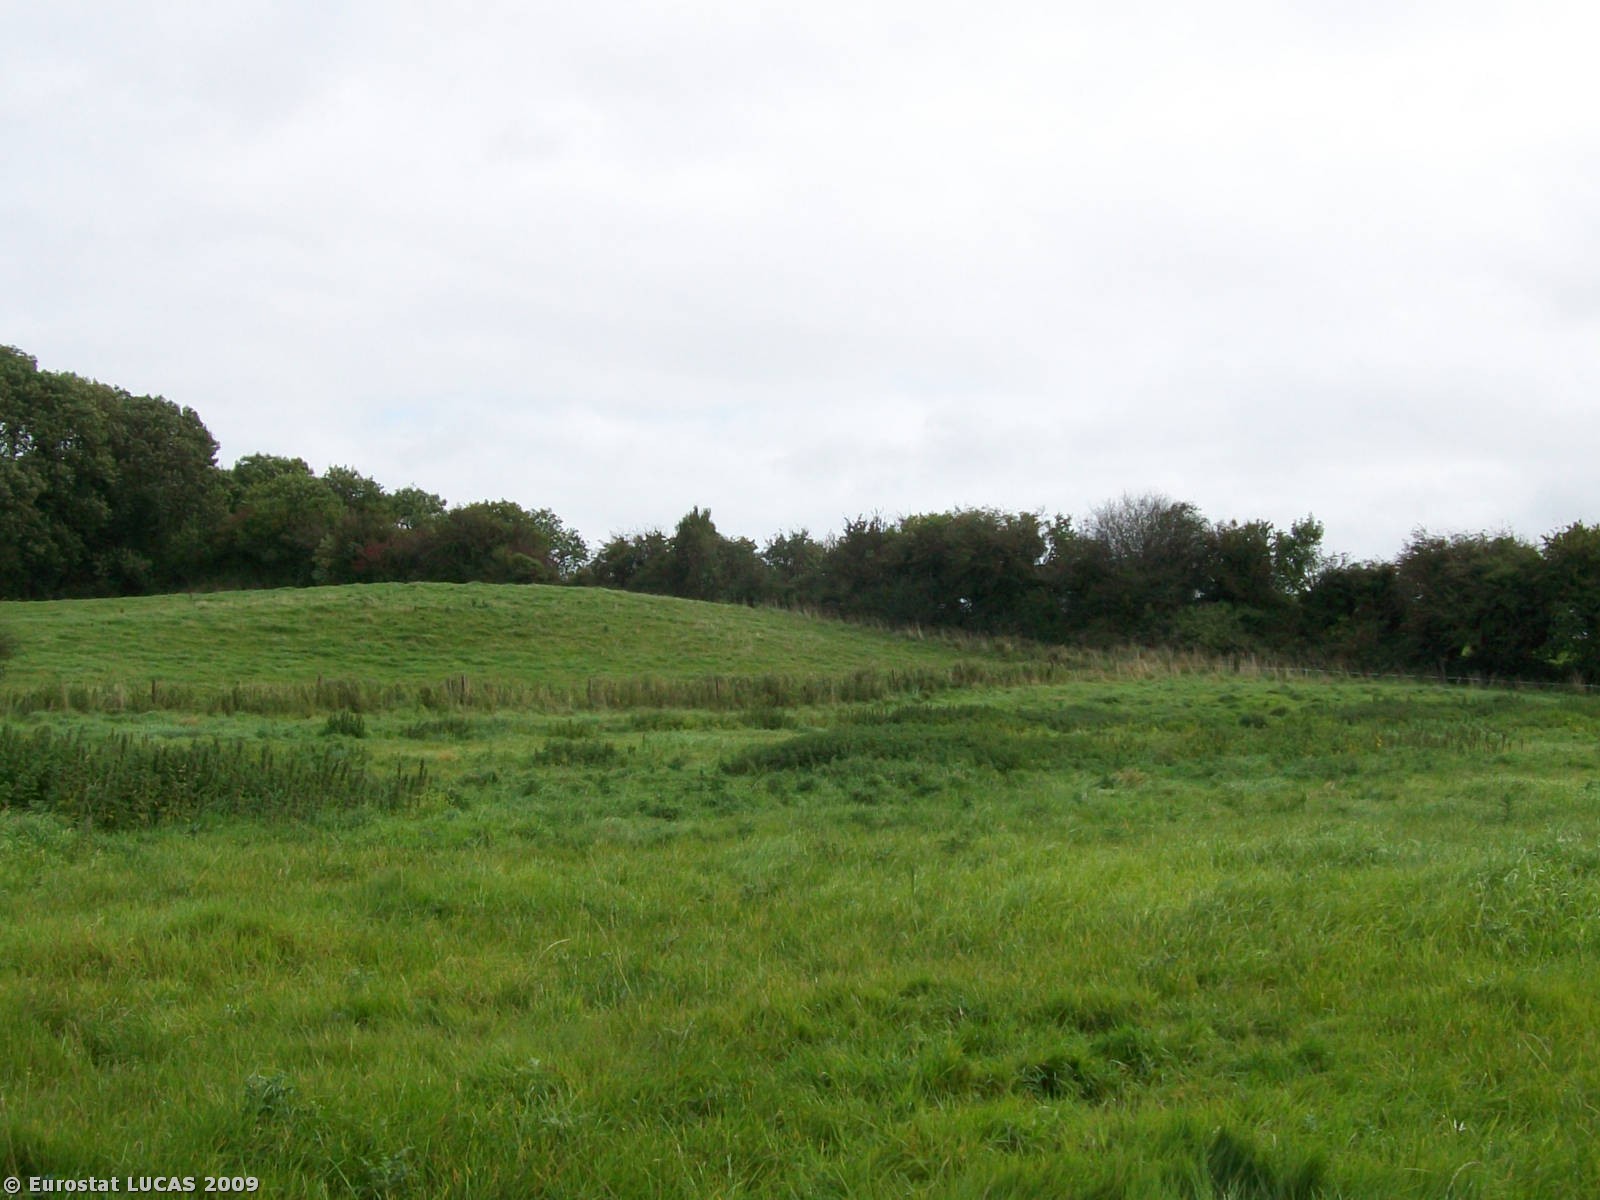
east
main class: Woodland
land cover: Coniferous woodland
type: plantations and self-sown exotic forest
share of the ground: > 75 %
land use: Forestry
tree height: > 5 m
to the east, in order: Coniferous woodland; Grassland without tree/shrub cover; Managed hedges; Ditches and canals; Grassland without tree/shrub cover
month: September
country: IE
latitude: 53.1507
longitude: -7.9527
